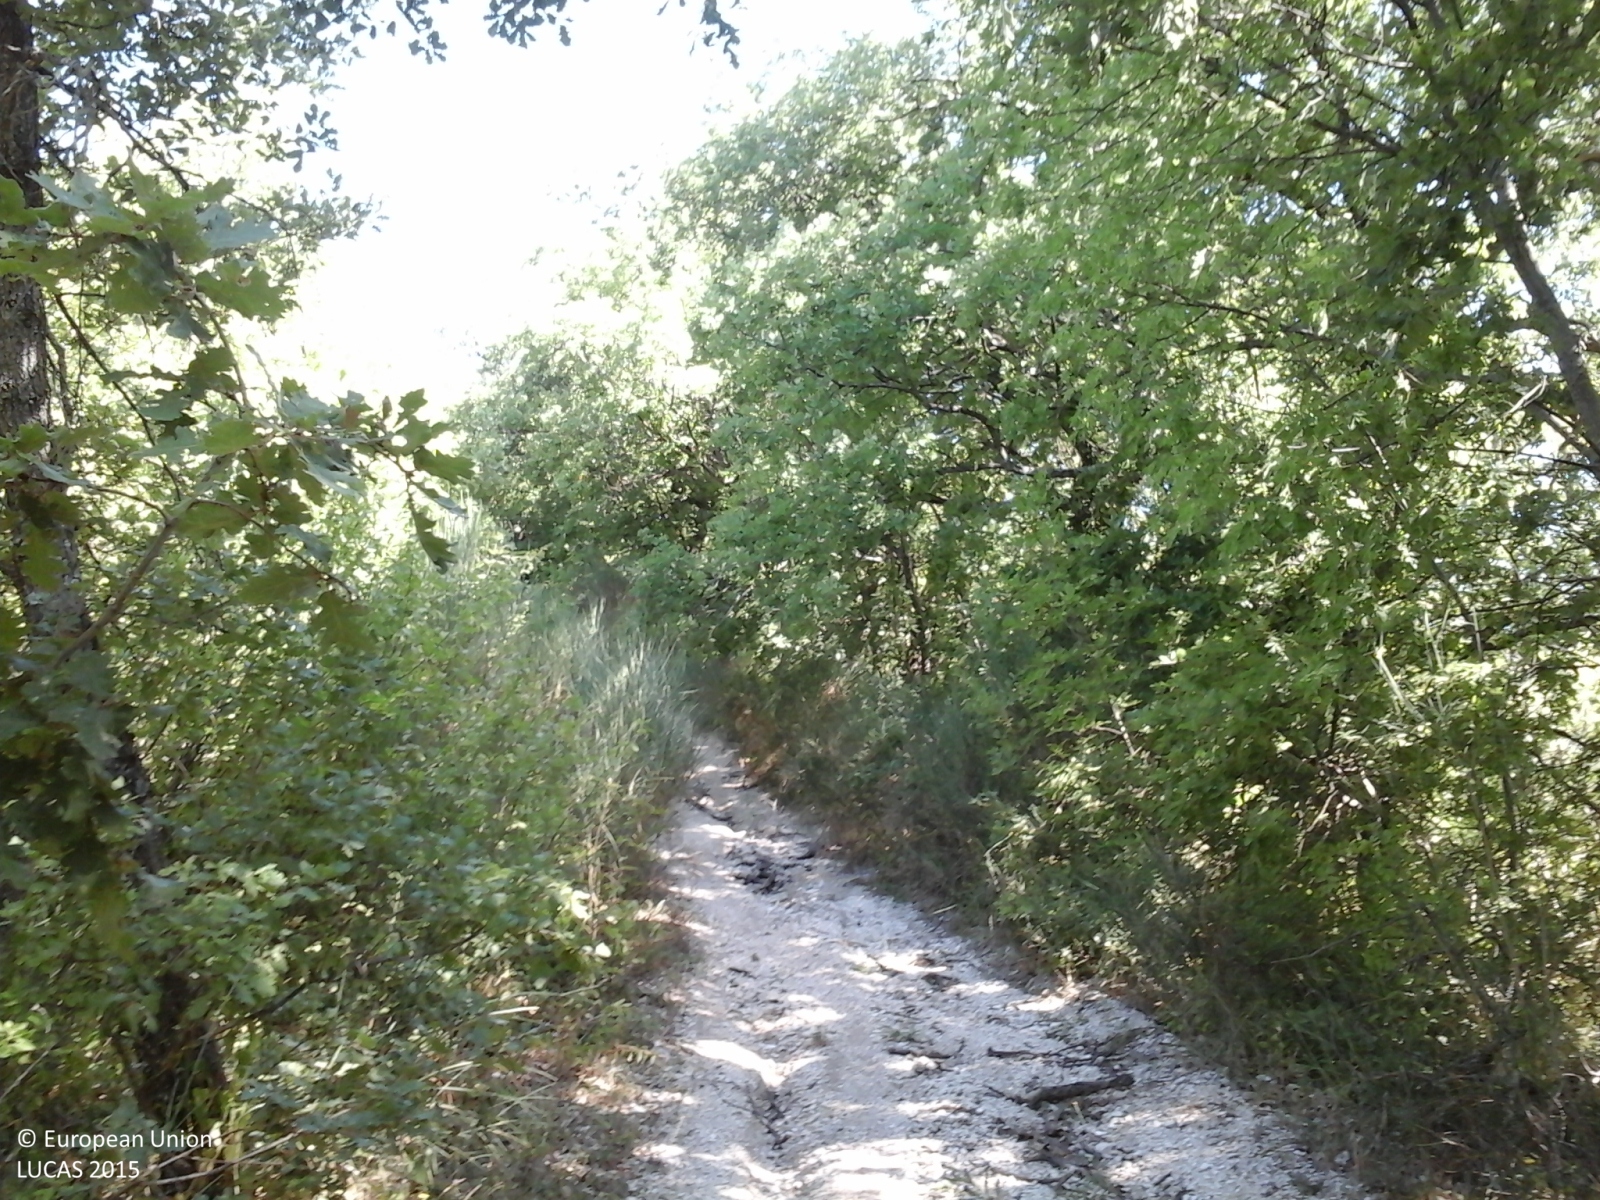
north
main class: Woodland
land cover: Broadleaved woodland
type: thermophilous deciduous forest
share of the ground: > 75 %
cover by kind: broadleaved forest trees 95 %, coniferous forest trees 5 %
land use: Forestry
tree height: > 5 m
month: August
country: IT
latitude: 43.1876
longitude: 13.0063
